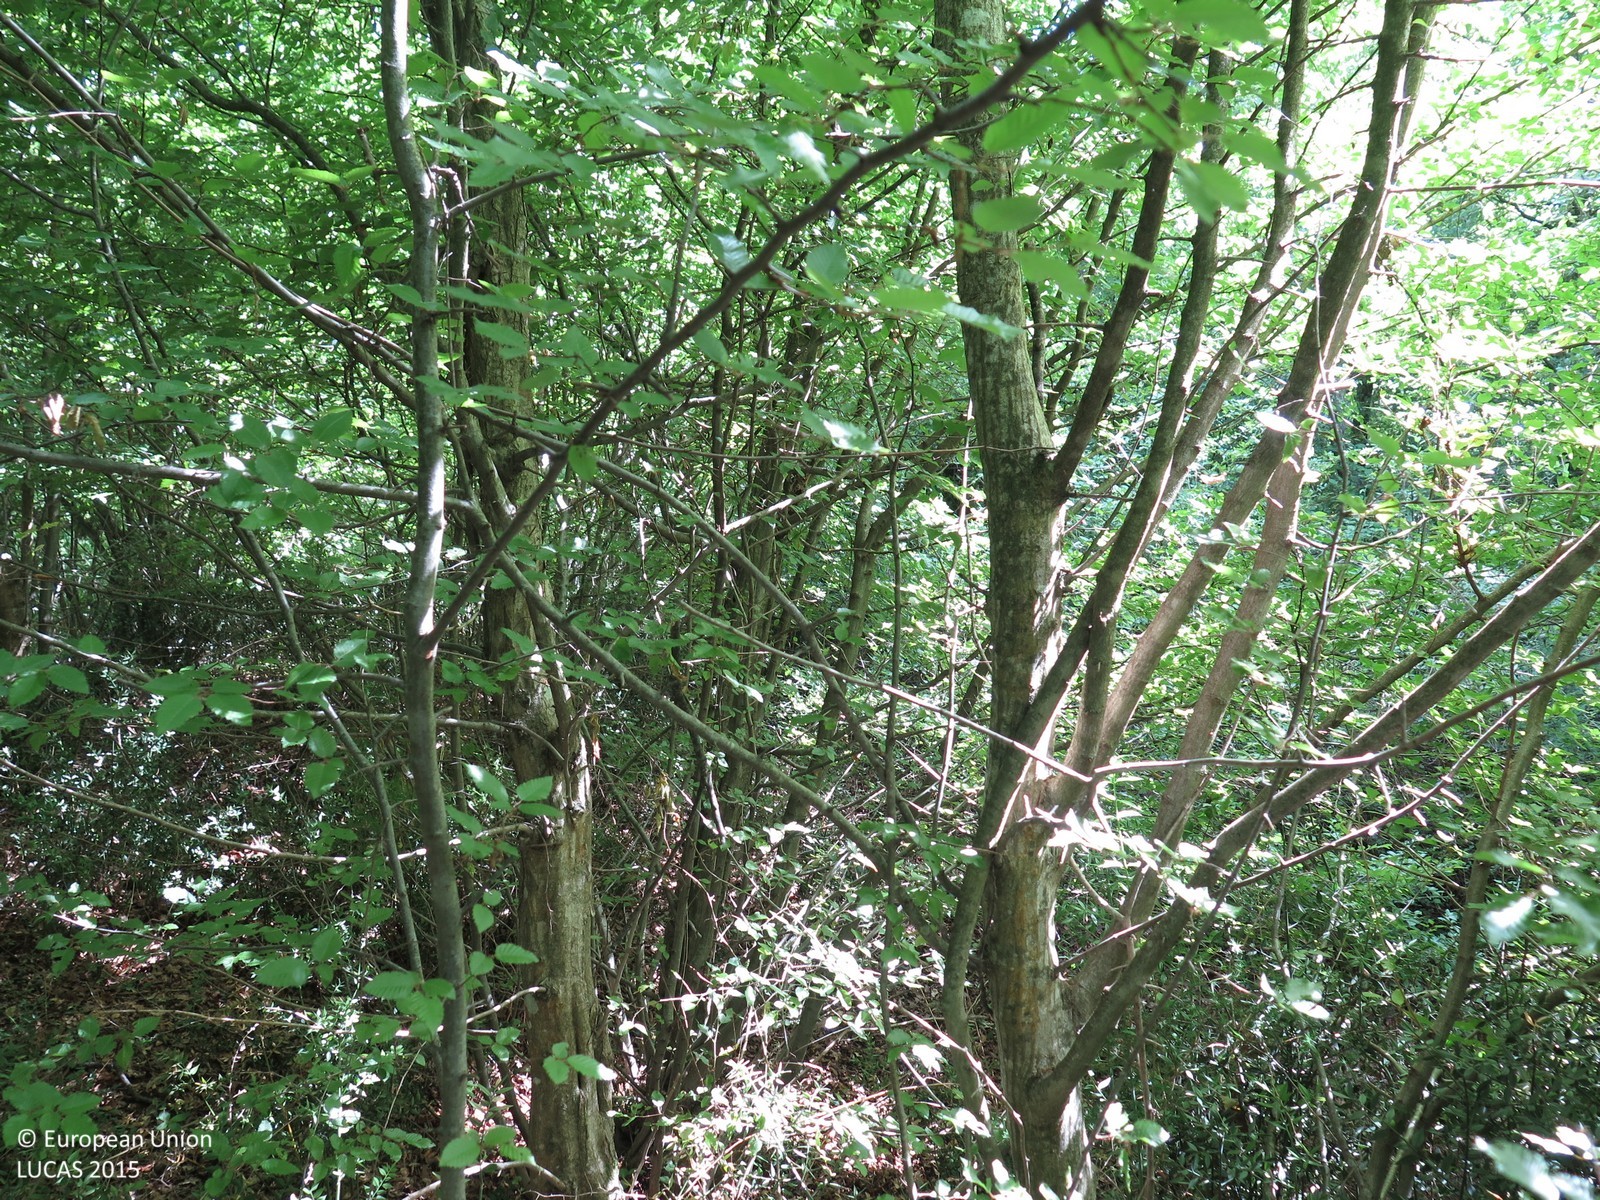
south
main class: Woodland
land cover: Broadleaved woodland
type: beech forest
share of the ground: > 75 %
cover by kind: broadleaved forest trees 90 %, shrubs 5 %, herbaceous plants 5 %
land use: Semi-natural and natural areas not in use
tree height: > 5 m
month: June
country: HR
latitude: 45.2608
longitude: 13.6524
